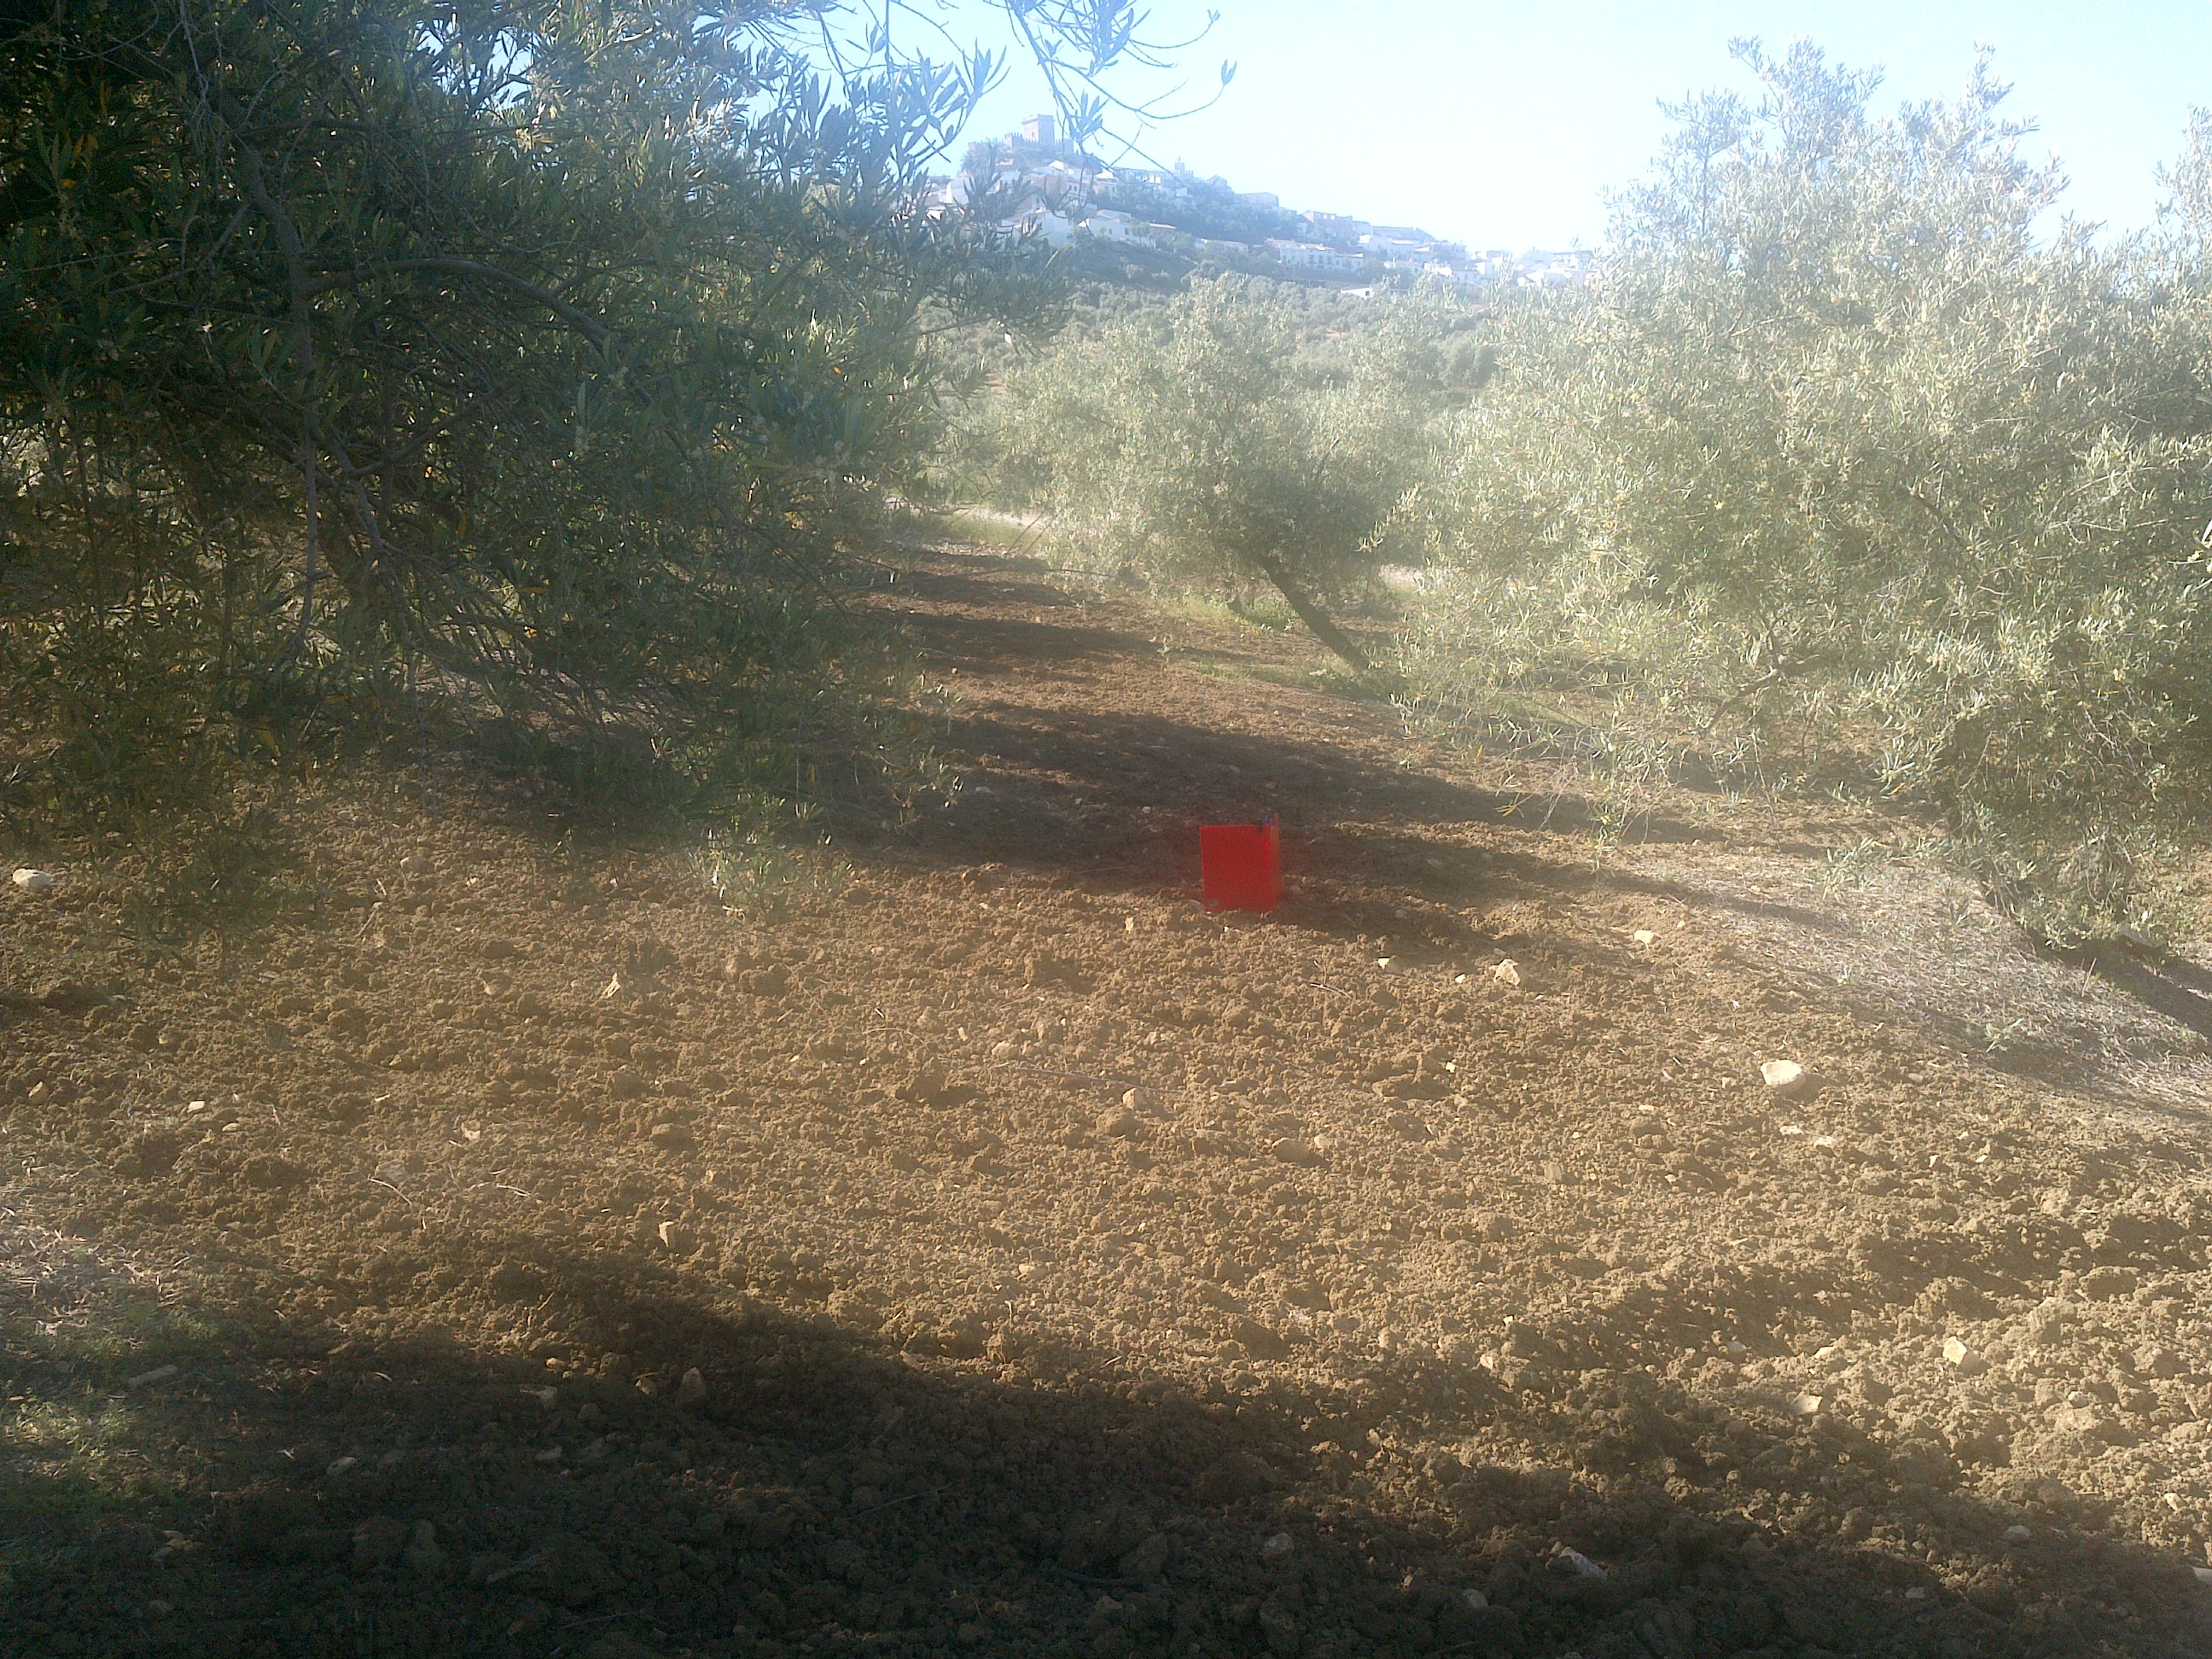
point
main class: Cropland
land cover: Olive groves
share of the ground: 50 - 75 %
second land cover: Other bare soil
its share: > 75 %
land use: Agriculture (excluding fallow land and kitchen gardens)
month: May
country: ES
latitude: 37.6874
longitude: -4.5573
